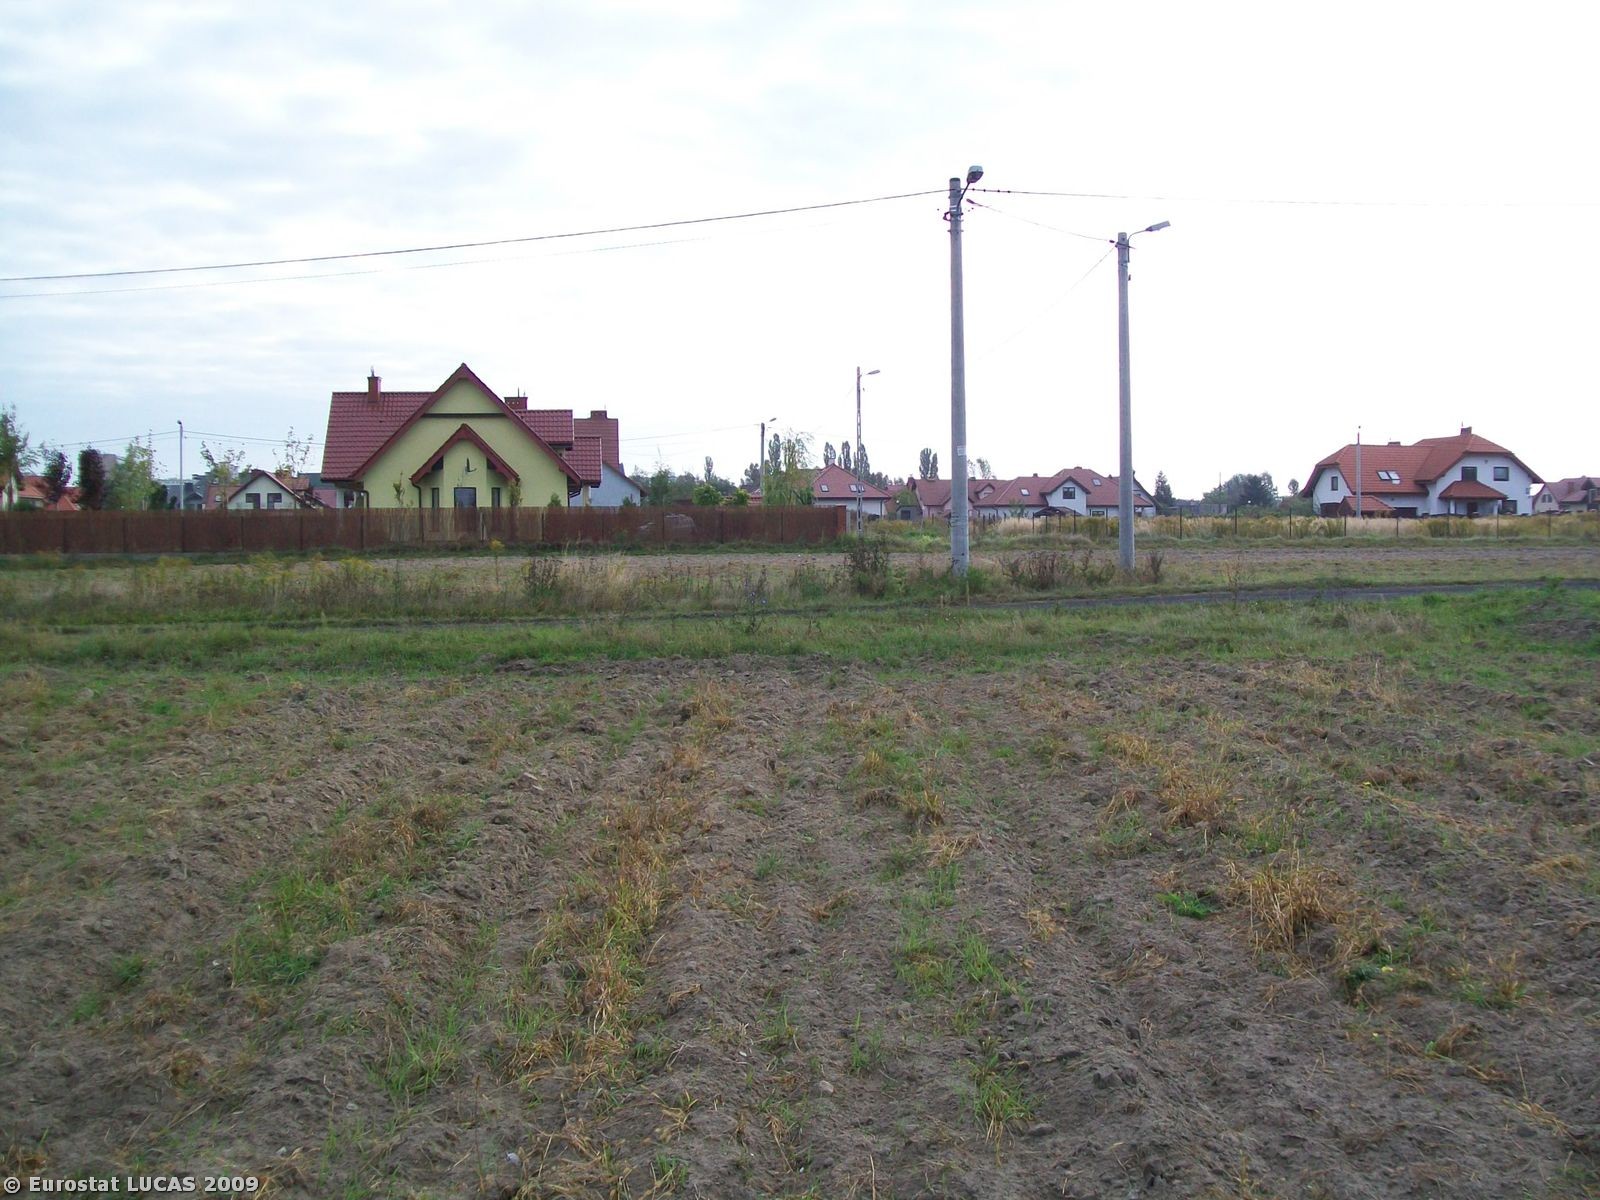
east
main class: Grassland
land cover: Grassland without tree/shrub cover
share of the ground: < 10 %
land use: Agriculture (excluding fallow land and kitchen gardens)
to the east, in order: Grassland without tree/shrub cover; Tracks; Electric lines; Grassland without tree/shrub cover; Grass margins; Fences; Artificial constructions in urban areas; Potatoes; Tracks; Fences; Artificial constructions in urban areas
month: September
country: PL
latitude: 52.1895
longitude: 20.8228
